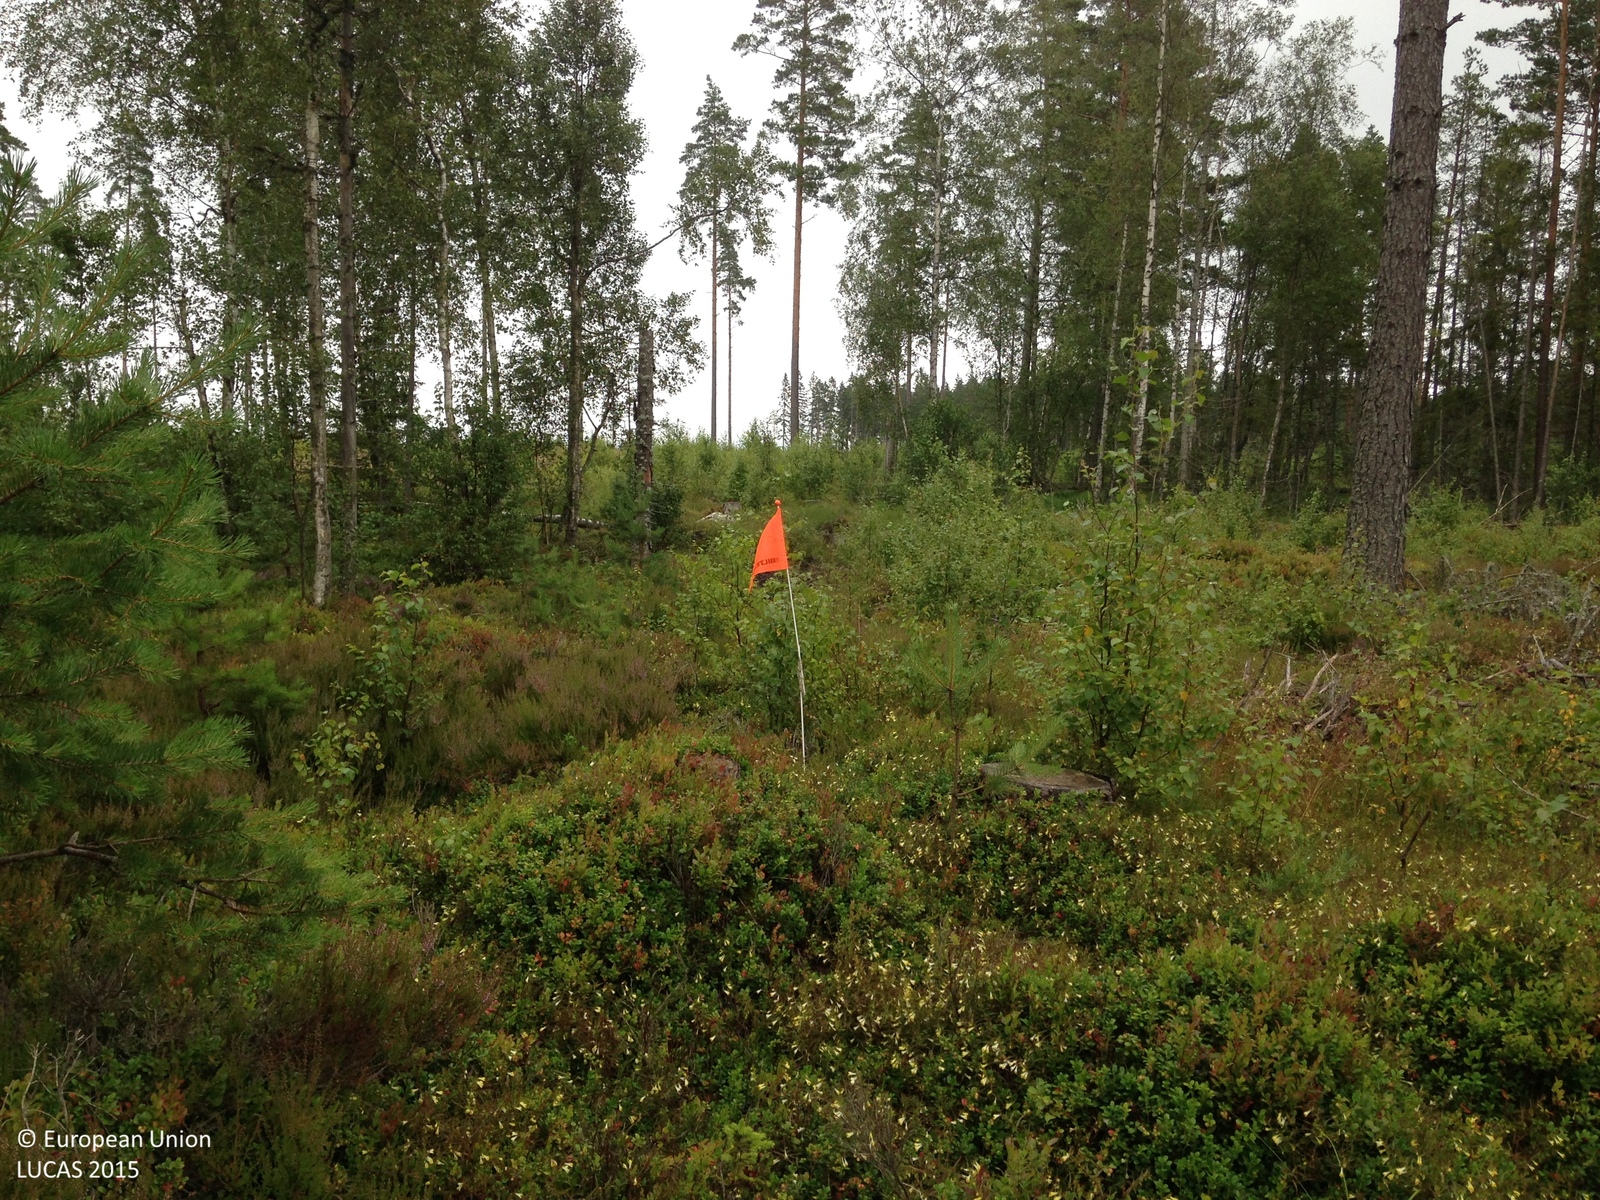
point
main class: Woodland
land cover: Broadleaved woodland
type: hemiboreal forest and nemoral coniferous forest and mixed broadleaved-coniferous forest
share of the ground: 25 - 50 %
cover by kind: broadleaved forest trees 40 %, herbaceous plants 30 %, shrubs 25 %, coniferous forest trees 5 %
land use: Forestry
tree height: < 5 m
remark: Clear cut
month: July
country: SE
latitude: 59.0439
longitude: 14.5413
